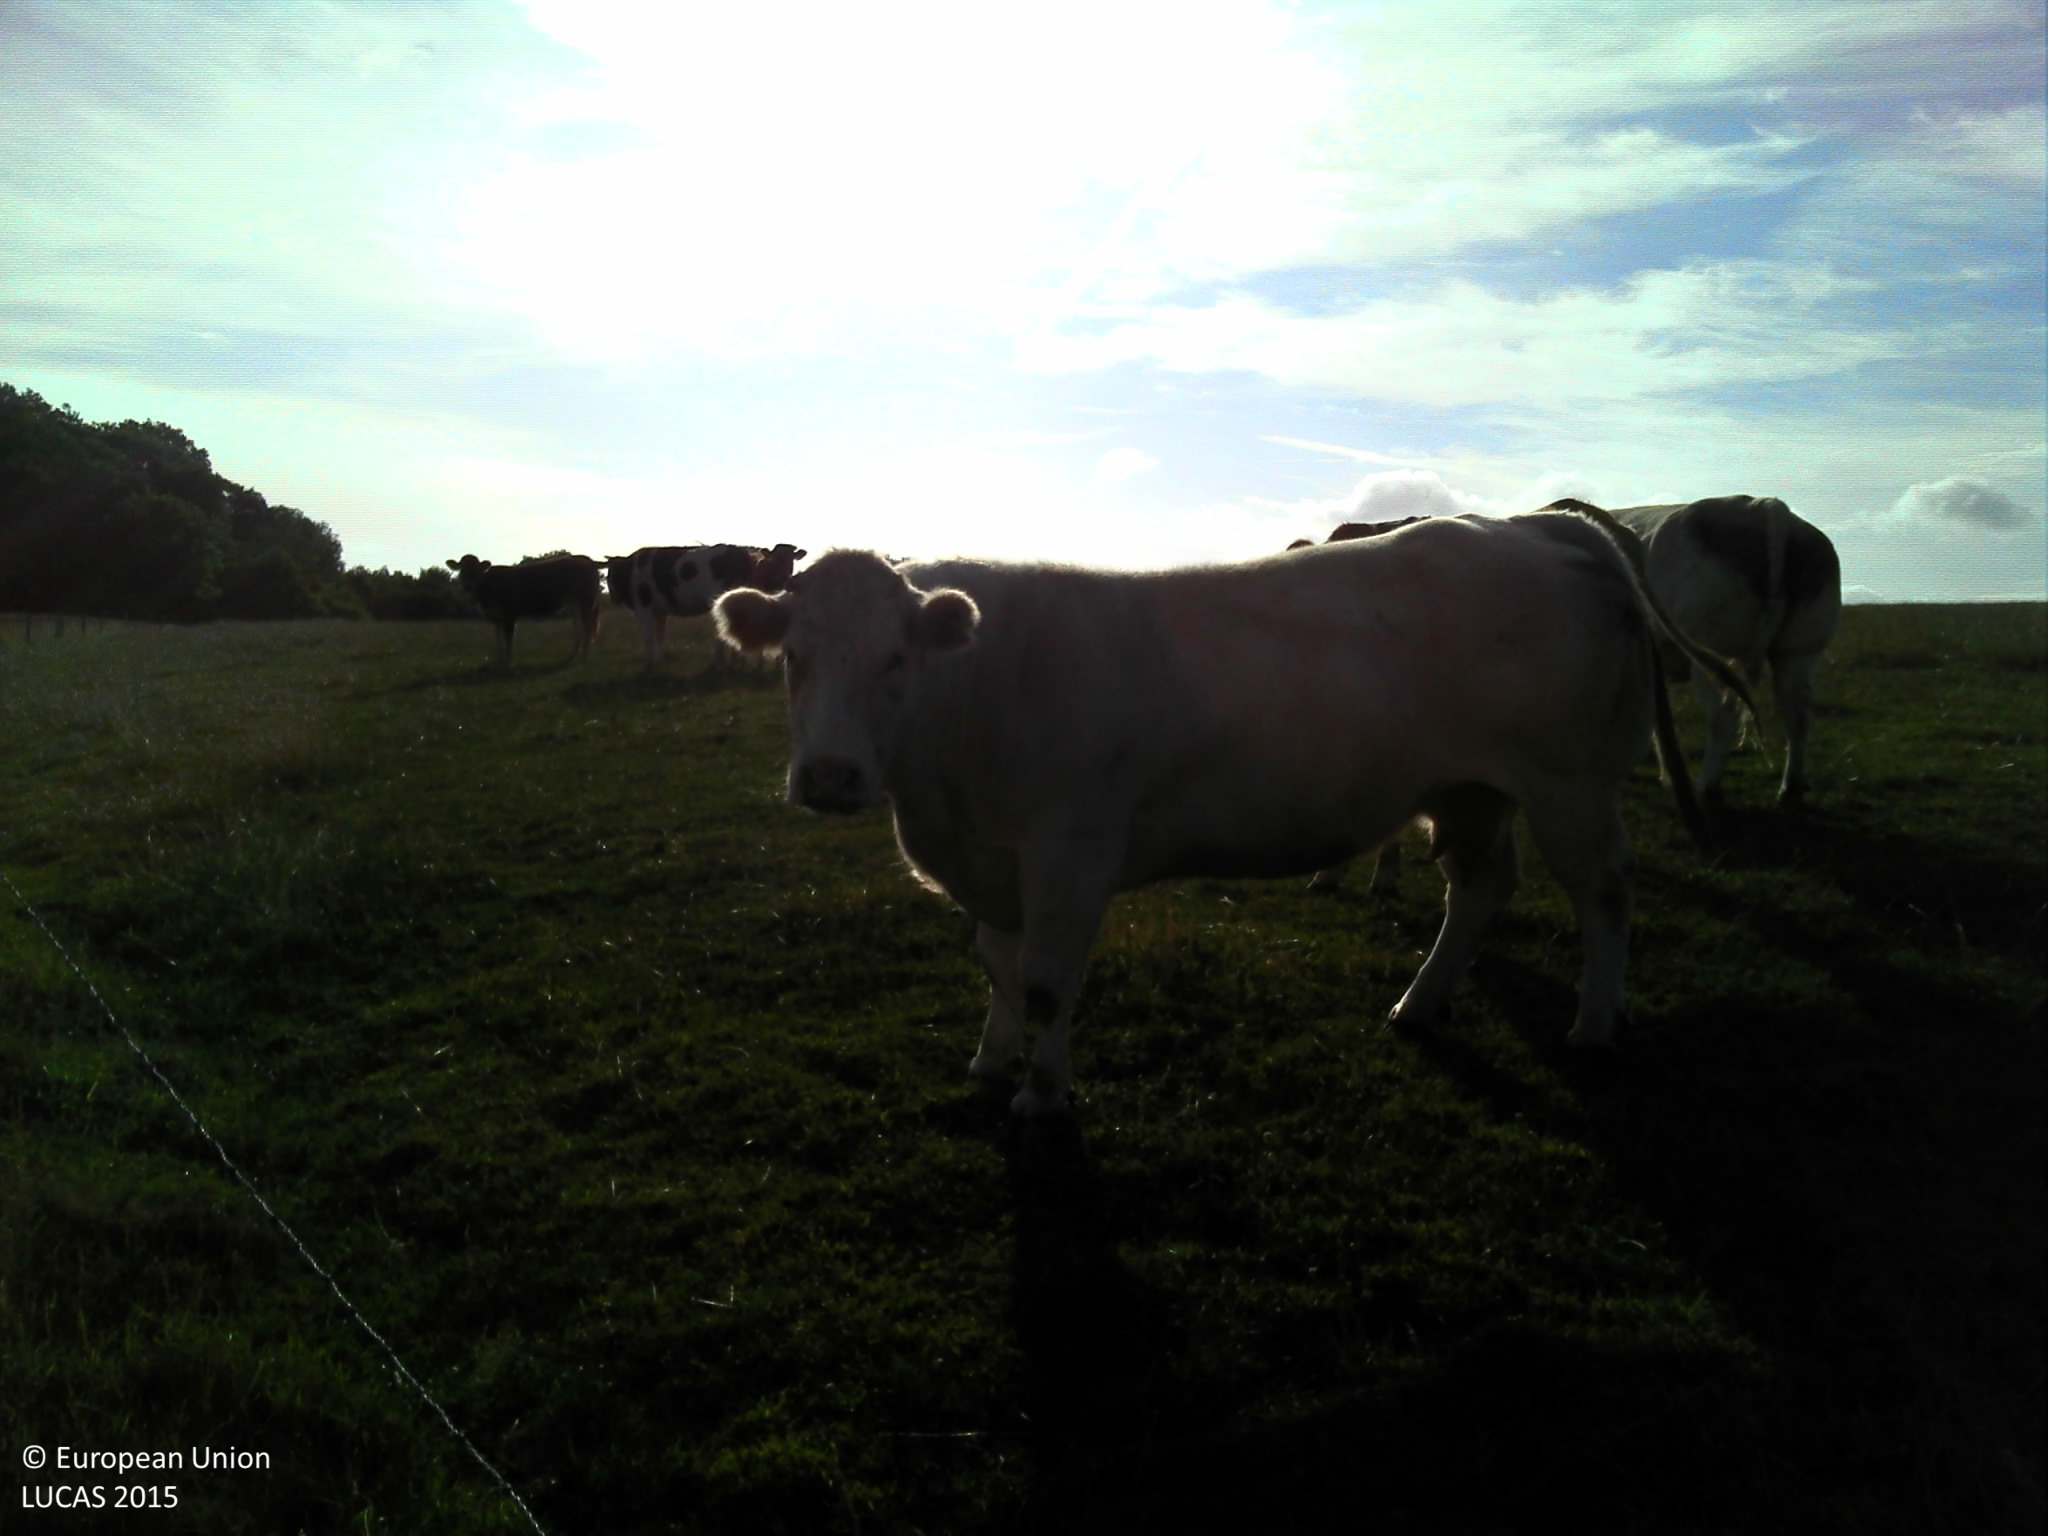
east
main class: Grassland
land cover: Grassland without tree/shrub cover
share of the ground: > 75 %
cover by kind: herbaceous plants 100 %
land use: Agriculture (excluding fallow land and kitchen gardens)
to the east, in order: Grassland without tree/shrub cover; Fences; Common wheat
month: July
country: BE
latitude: 49.7117
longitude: 5.8247
